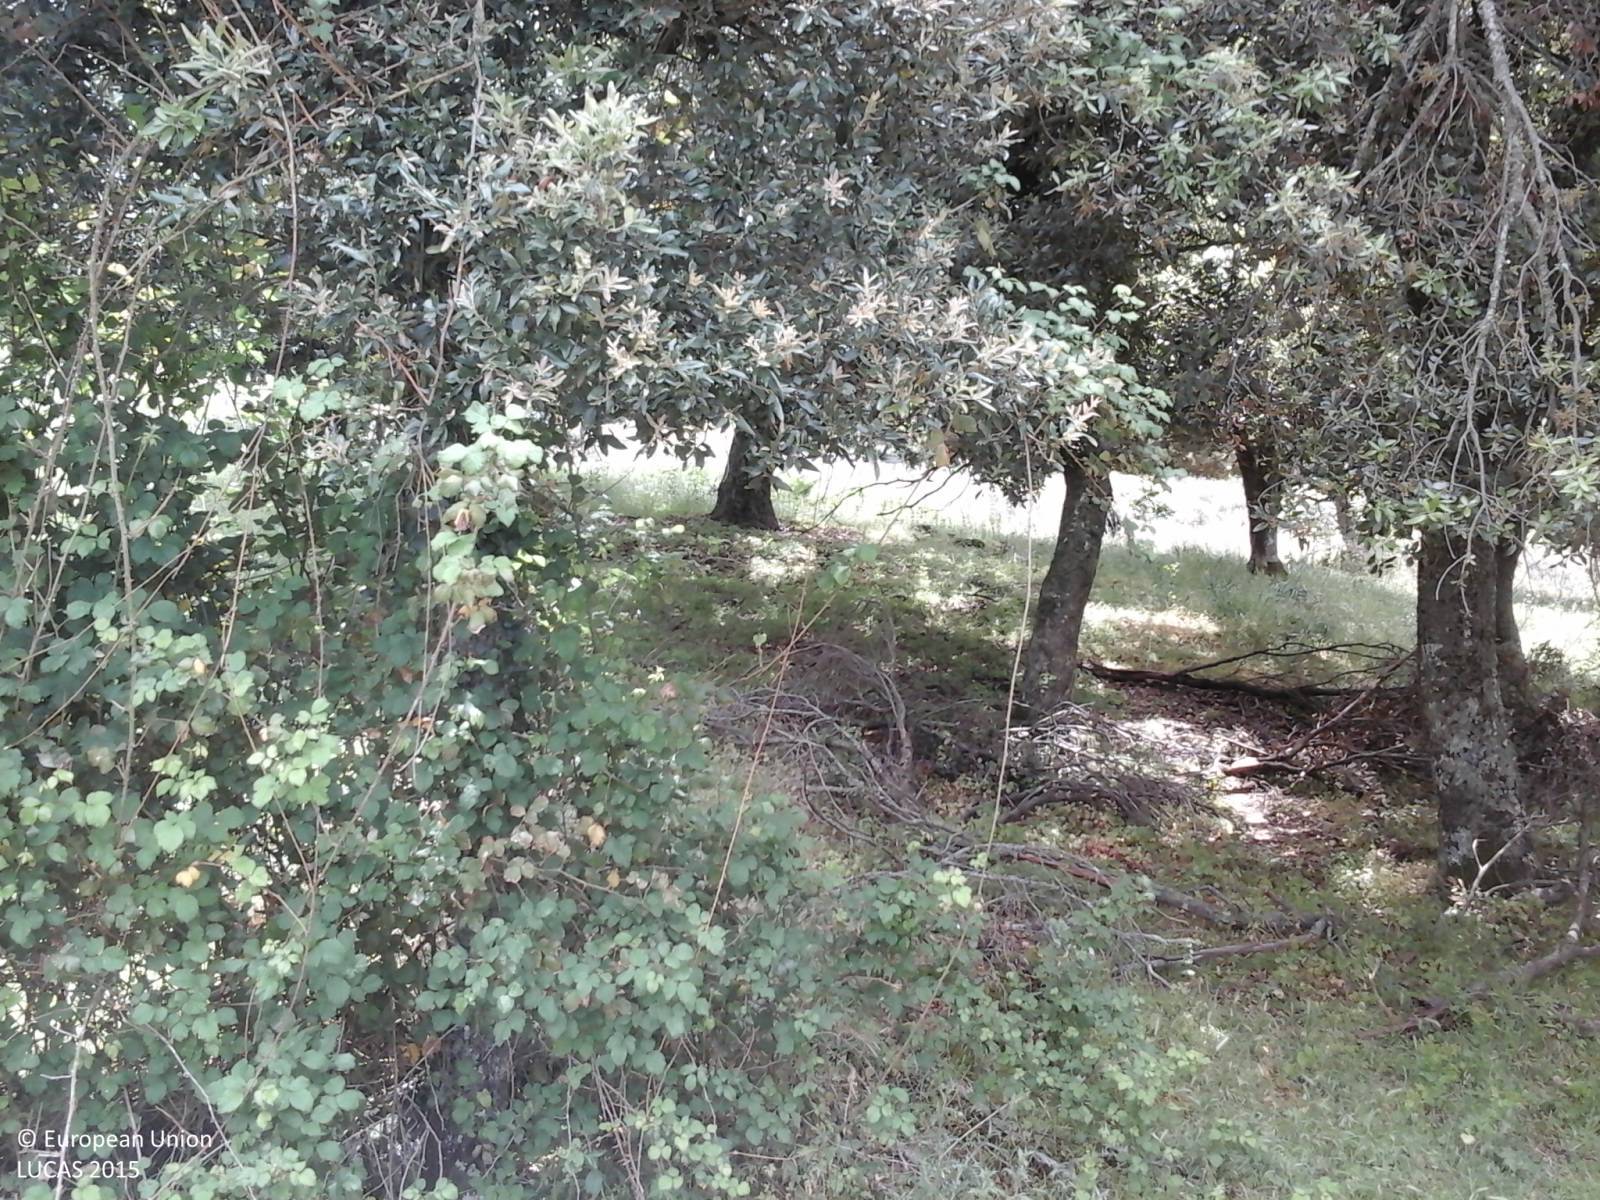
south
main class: Woodland
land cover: Broadleaved woodland
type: broadleaved evergreen forest
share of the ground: > 75 %
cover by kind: broadleaved forest trees 85 %, shrubs 5 %
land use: Forestry
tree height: > 5 m
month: May
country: IT
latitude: 40.2099
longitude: 9.2170
